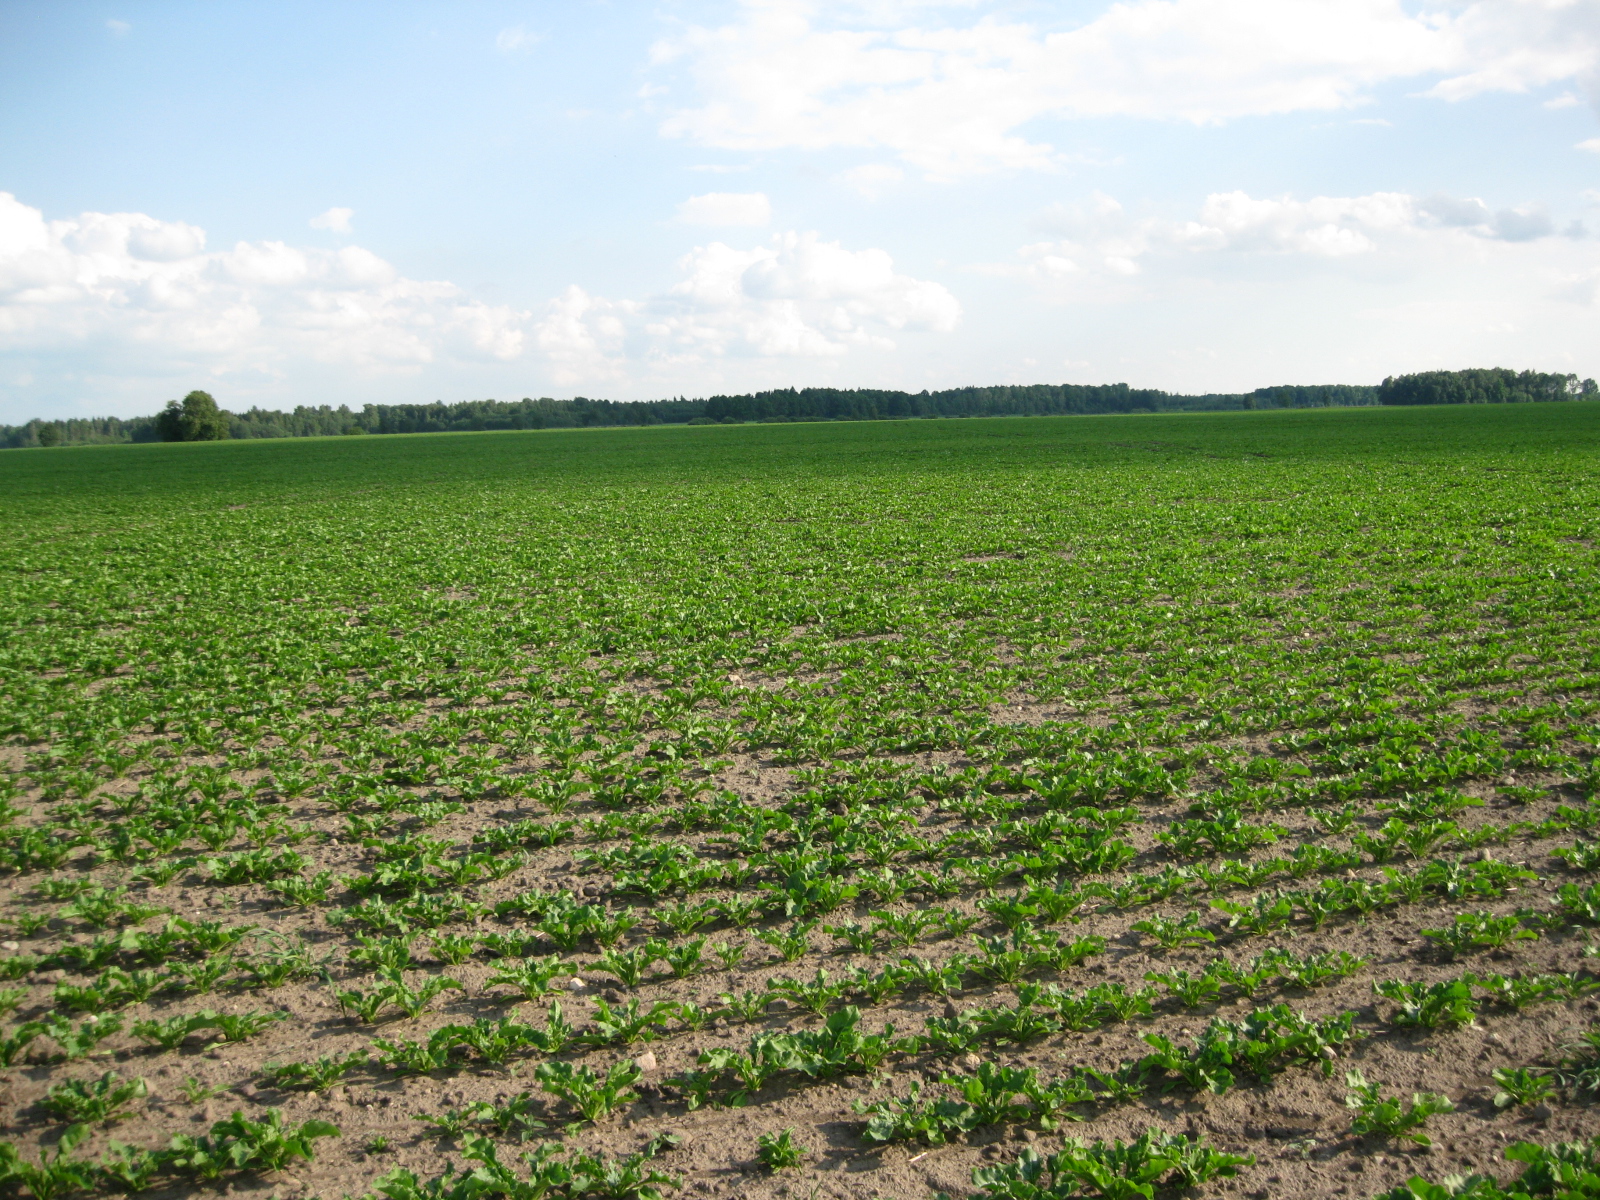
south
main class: Cropland
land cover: Sugar beet
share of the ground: 25 - 50 %
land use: Agriculture (excluding fallow land and kitchen gardens)
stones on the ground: < 10 %
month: June
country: LT
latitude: 55.5616
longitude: 23.8321
